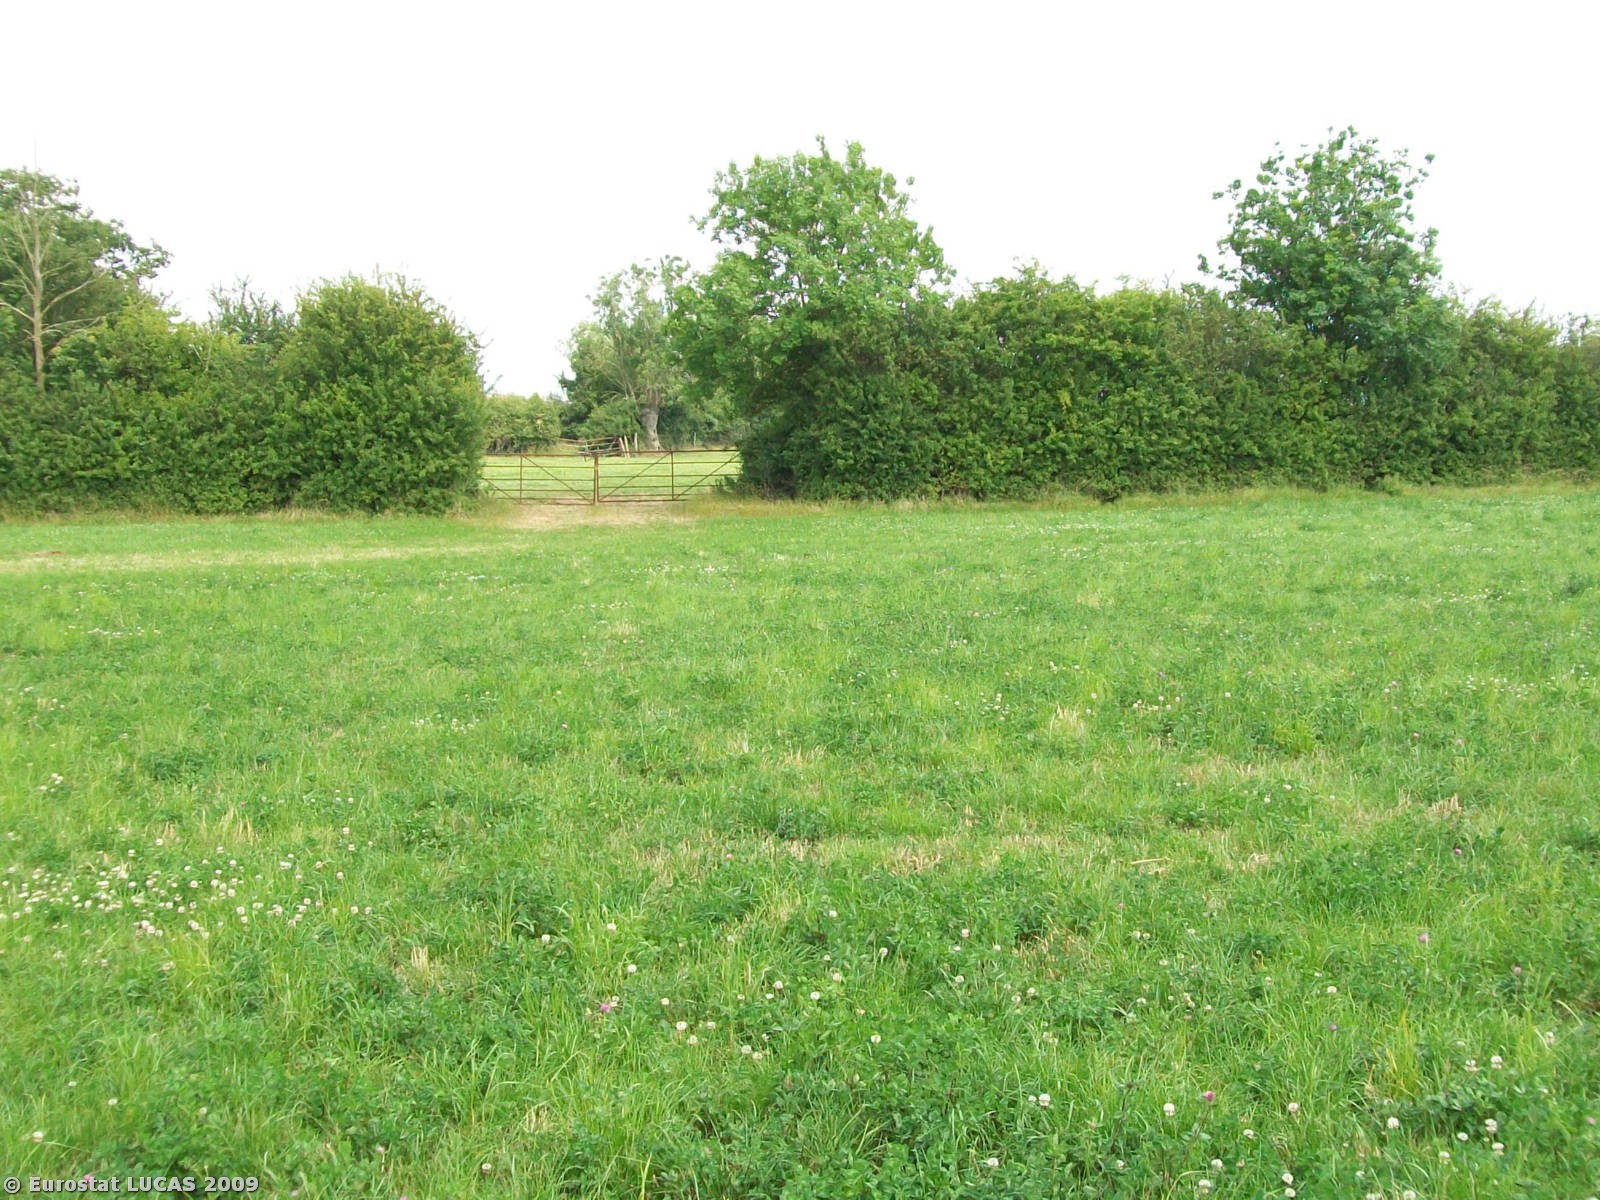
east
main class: Grassland
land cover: Grassland without tree/shrub cover
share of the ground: > 75 %
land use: Agriculture (excluding fallow land and kitchen gardens)
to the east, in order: Grassland without tree/shrub cover; Managed hedges; Fences; Grassland without tree/shrub cover; Fences; Tracks; Fences; Grassland without tree/shrub cover
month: June
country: GB
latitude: 51.2838
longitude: -2.2639
